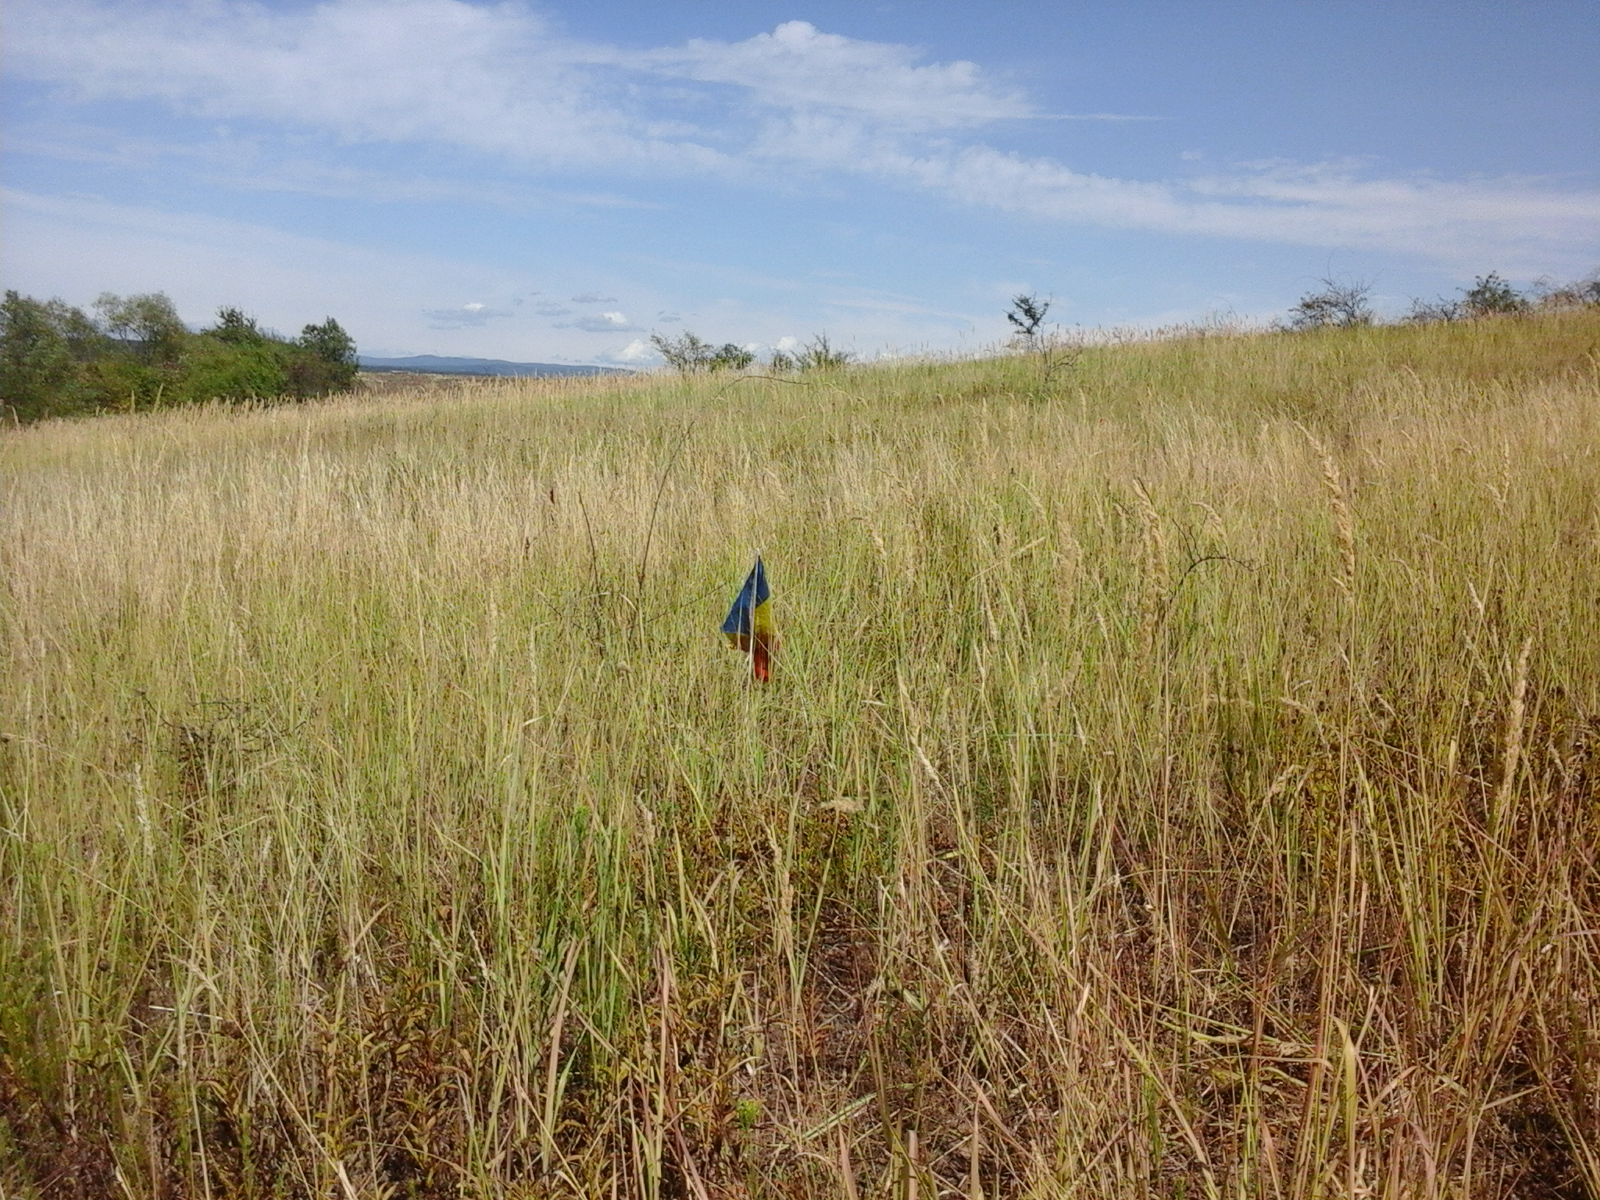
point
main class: Grassland
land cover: Grassland with sparse tree/shrub cover
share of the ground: > 75 %
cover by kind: herbaceous plants 95 %, broadleaved forest trees 5 %
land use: Agriculture (excluding fallow land and kitchen gardens)
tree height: < 5 m
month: August
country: RO
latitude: 45.2039
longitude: 21.4754
